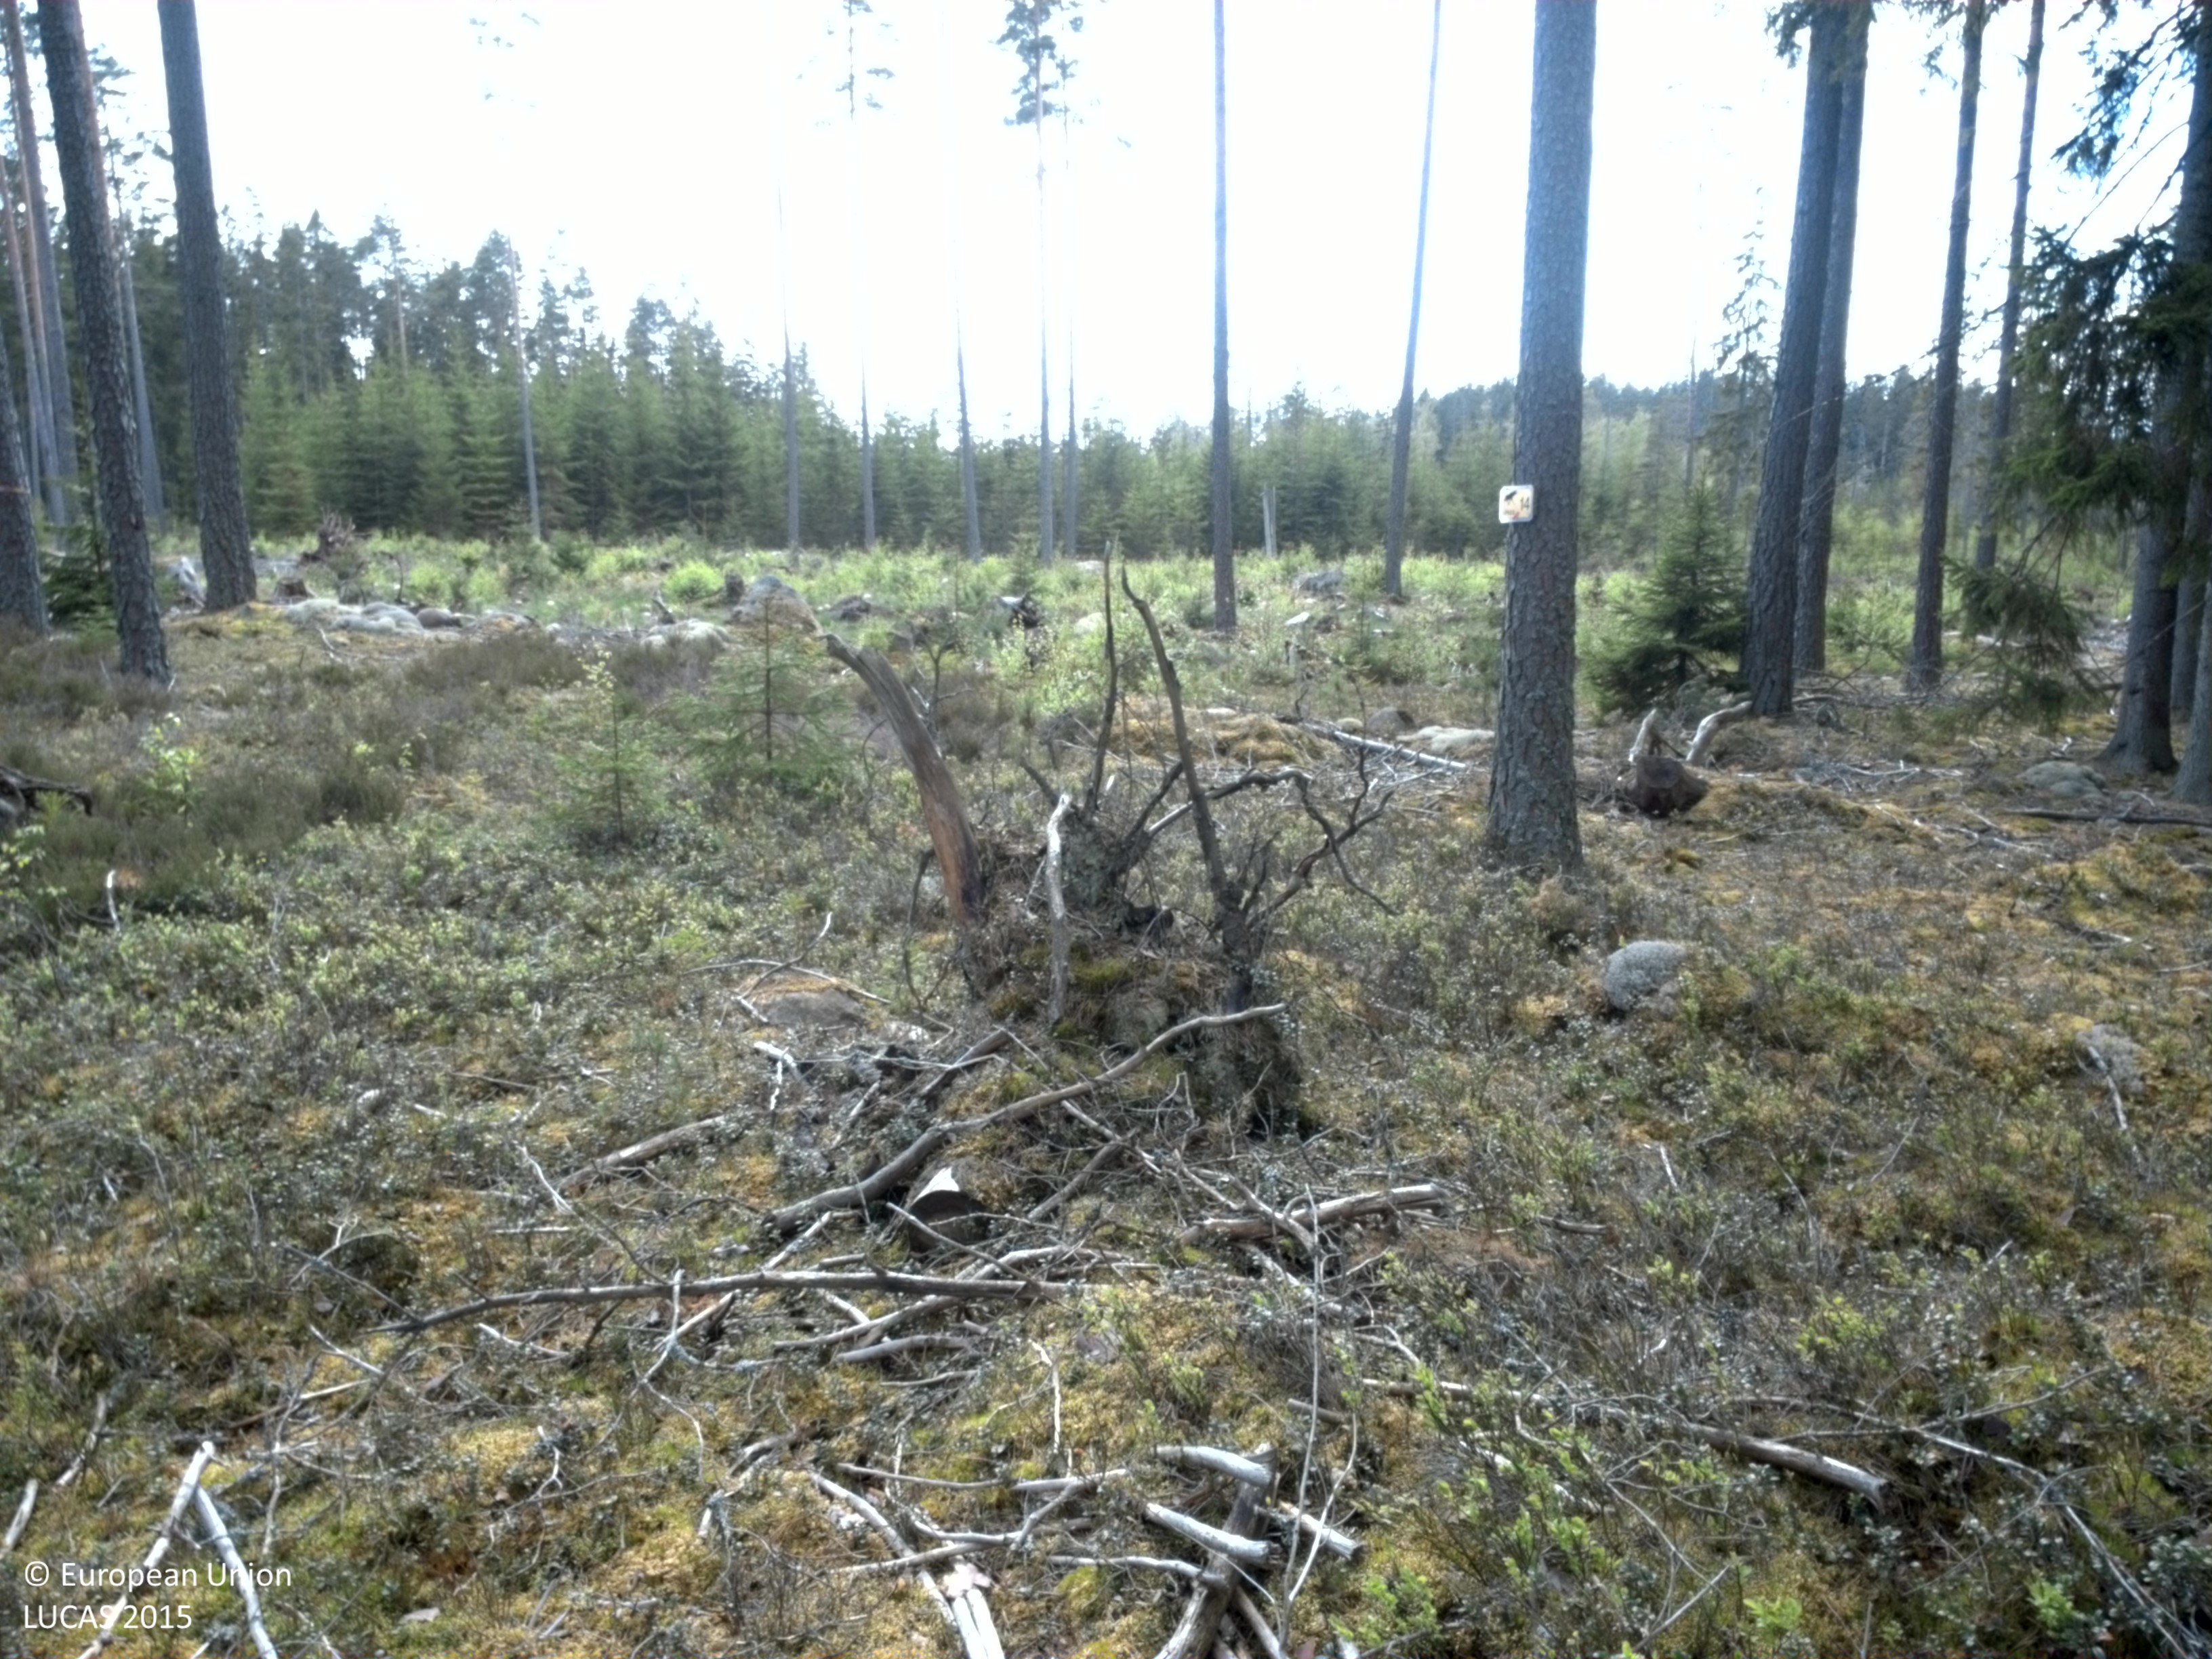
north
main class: Woodland
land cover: Pine dominated coniferous woodland
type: boreal forest
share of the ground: 50 - 75 %
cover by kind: coniferous forest trees 40 %, shrubs 35 %, lichens and mosses 15 %, broadleaved forest trees 10 %
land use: Forestry
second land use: Amenities, museums, leisure
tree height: > 5 m
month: May
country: SE
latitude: 56.8229
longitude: 15.1590
